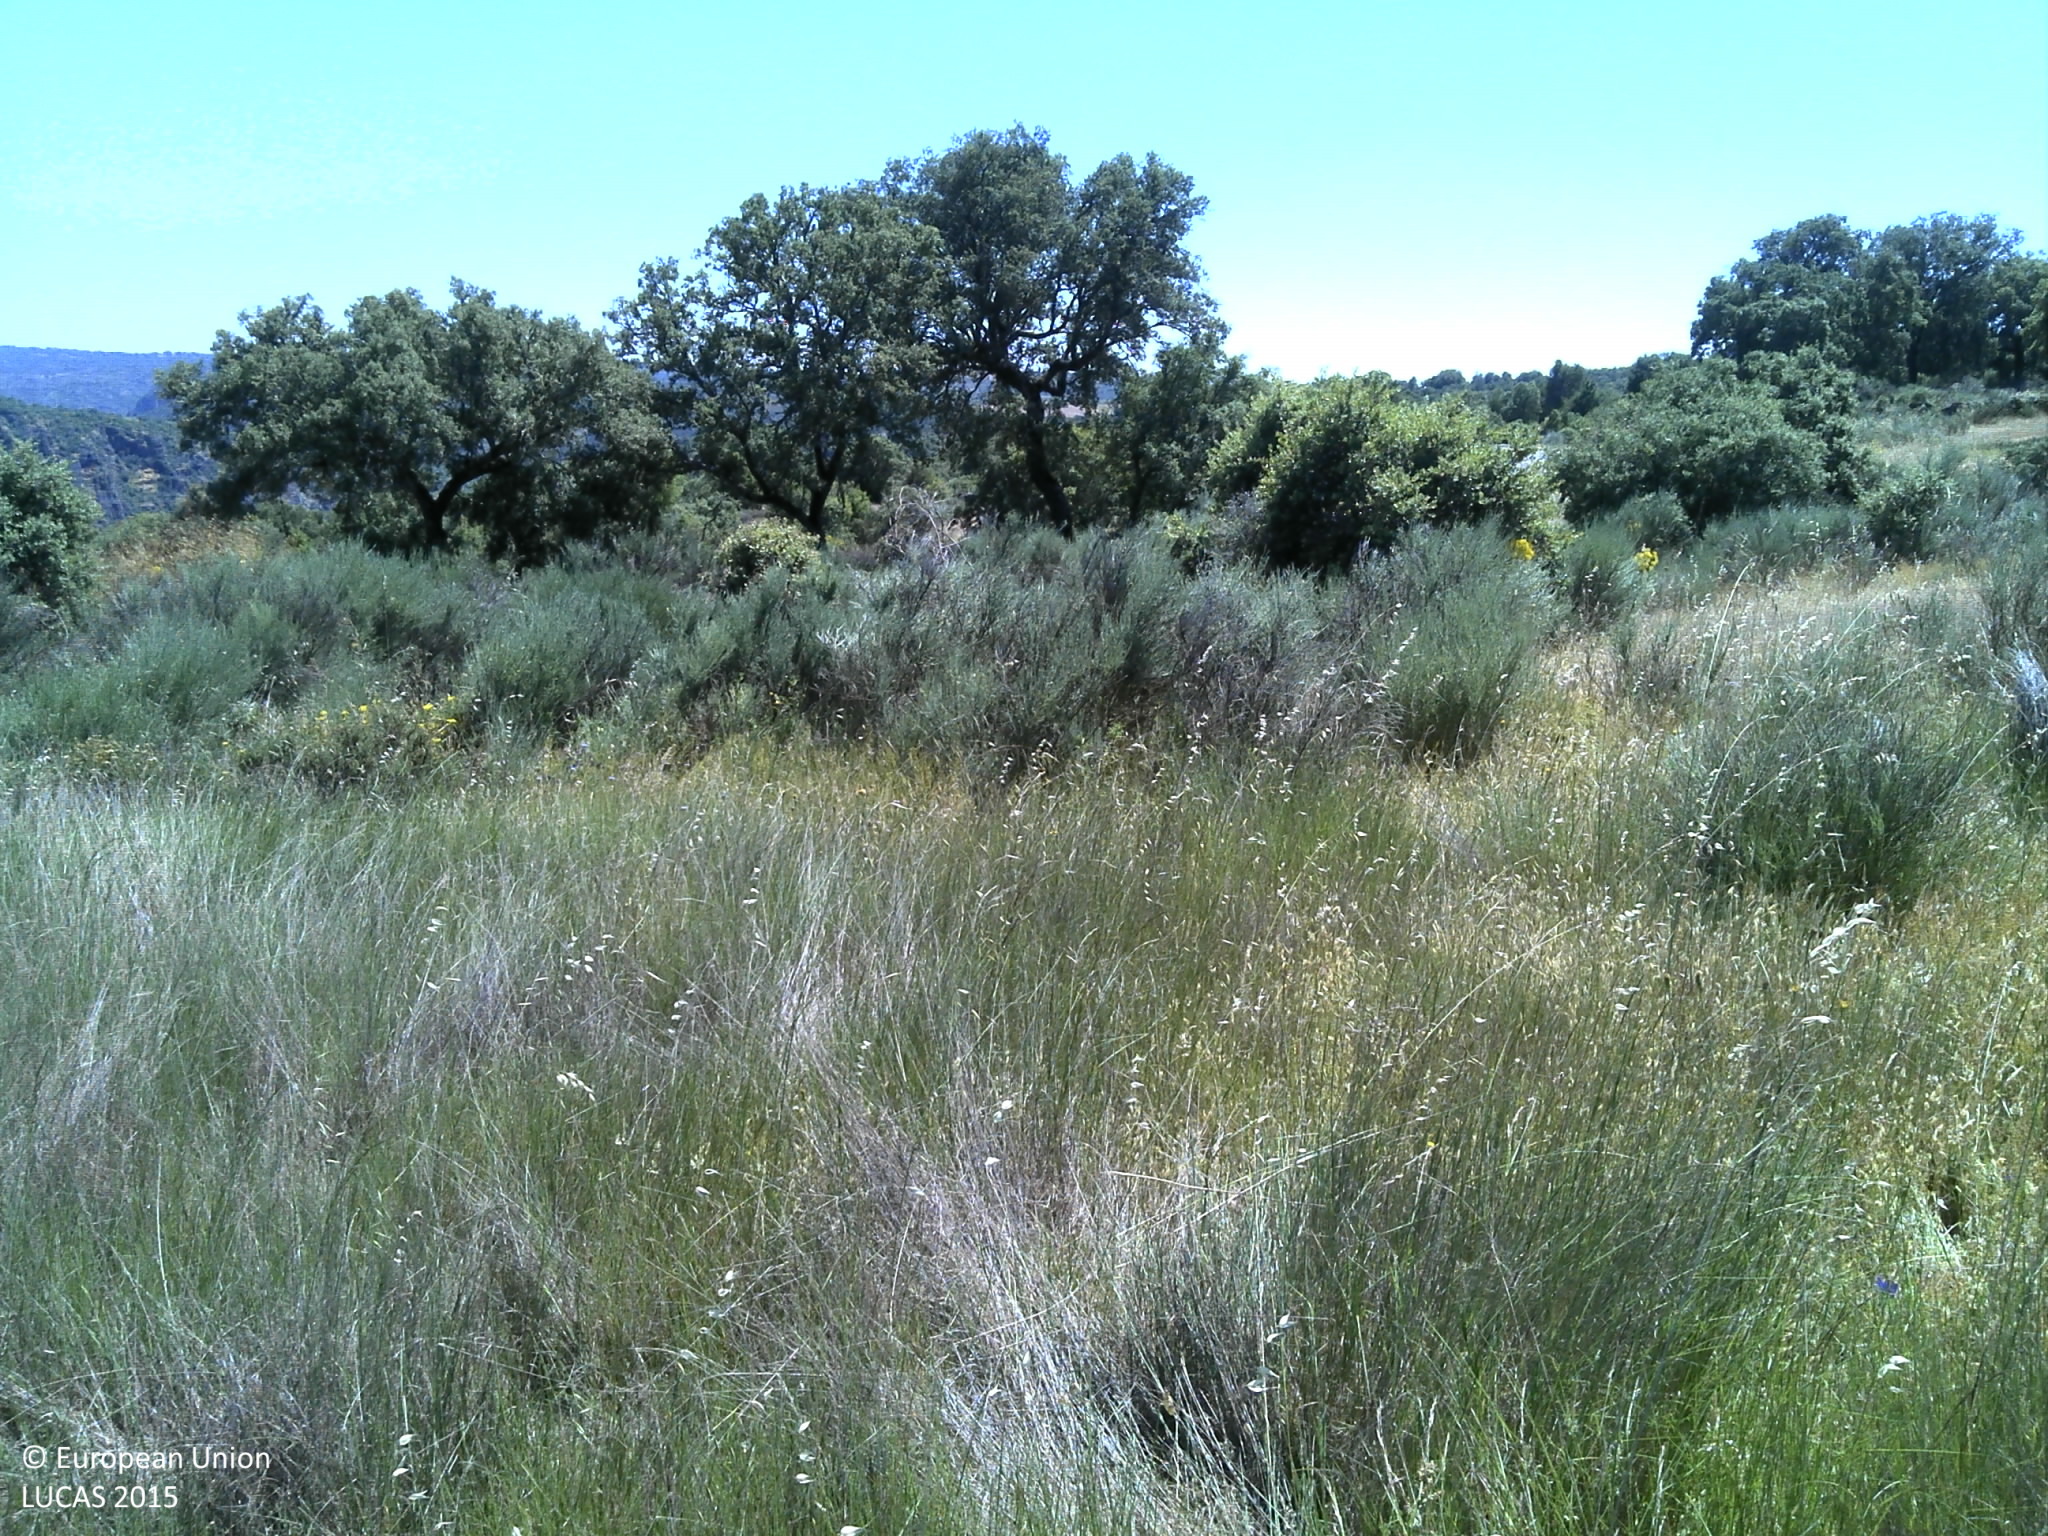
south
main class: Grassland
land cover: Grassland with sparse tree/shrub cover
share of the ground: > 75 %
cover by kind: herbaceous plants 80 %, unconsolidated bare surface 15 %, broadleaved forest trees 5 %
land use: Agriculture (excluding fallow land and kitchen gardens)
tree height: > 5 m
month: May
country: PT
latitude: 41.4276
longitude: -6.3360
